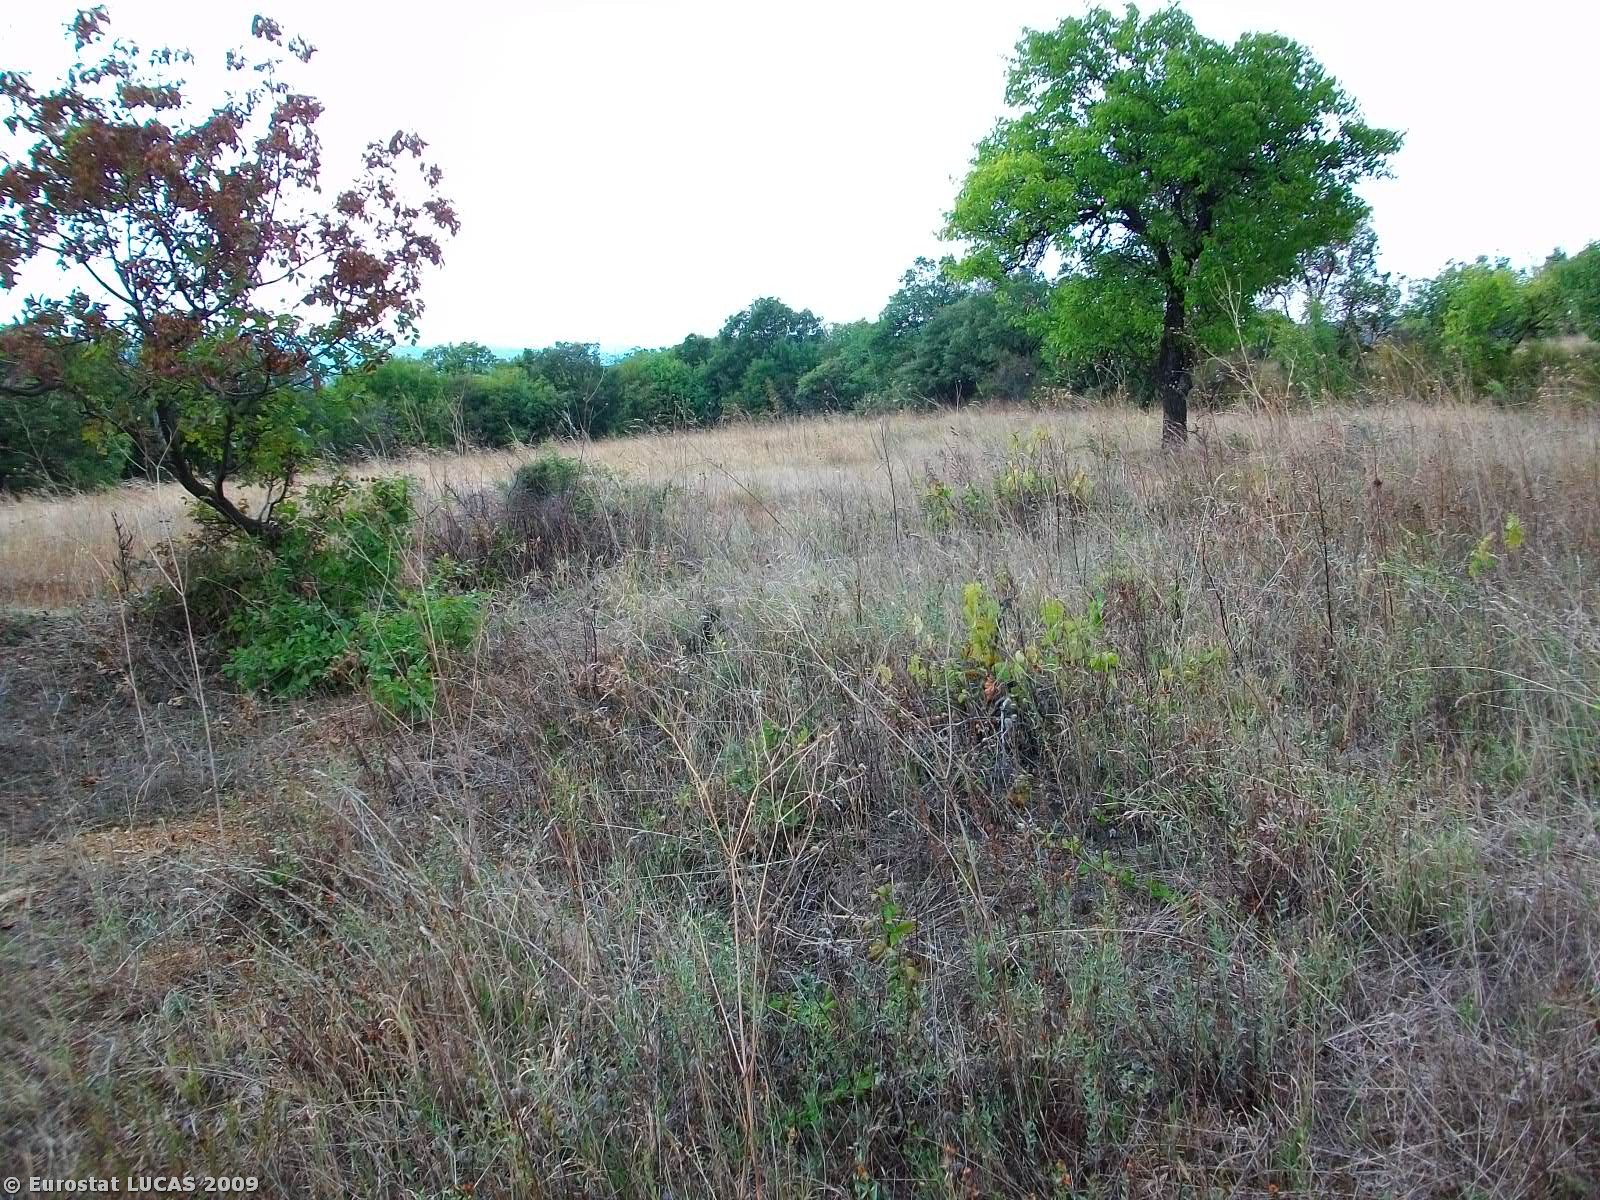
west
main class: Cropland
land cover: Vineyards
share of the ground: < 10 %
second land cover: Grassland with sparse tree/shrub cover
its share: > 75 %
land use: Fallow land
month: September
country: GR
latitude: 41.2751
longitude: 26.3683
